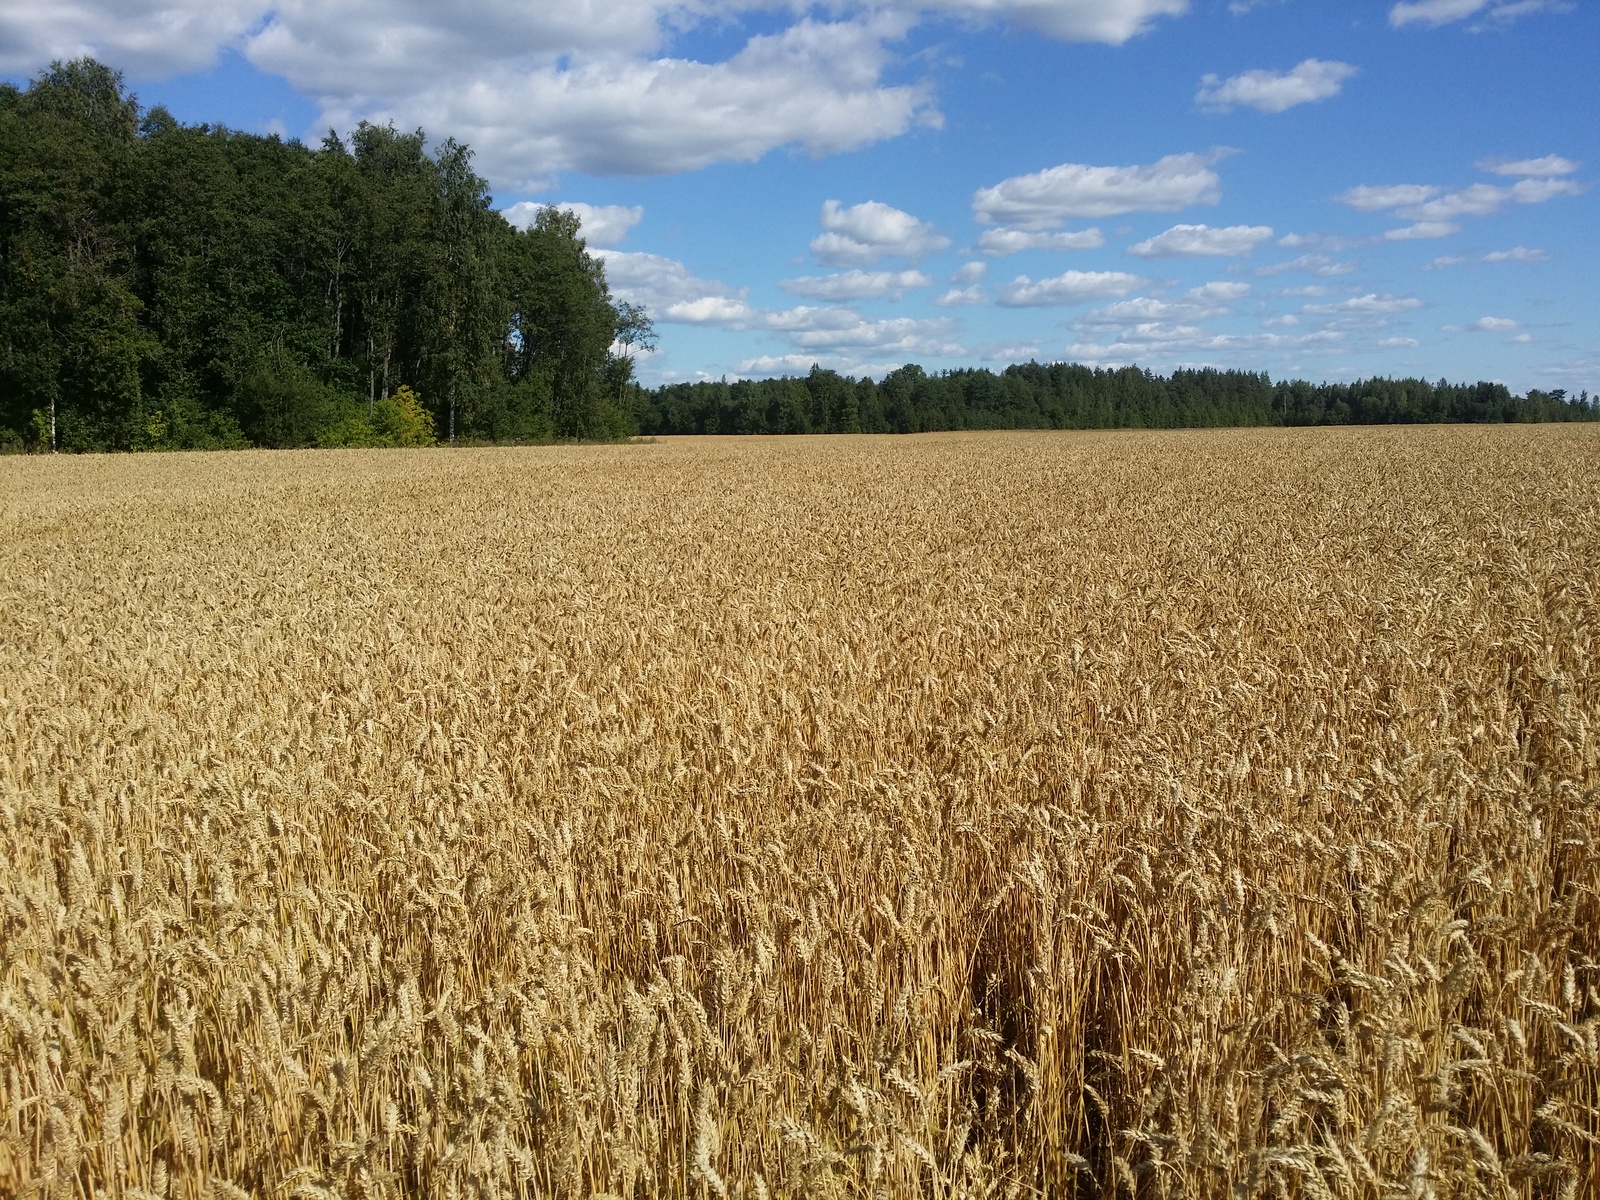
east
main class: Cropland
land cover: Common wheat
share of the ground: > 75 %
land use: Agriculture (excluding fallow land and kitchen gardens)
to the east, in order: Common wheat
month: August
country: LV
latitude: 56.9951
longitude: 27.6804
